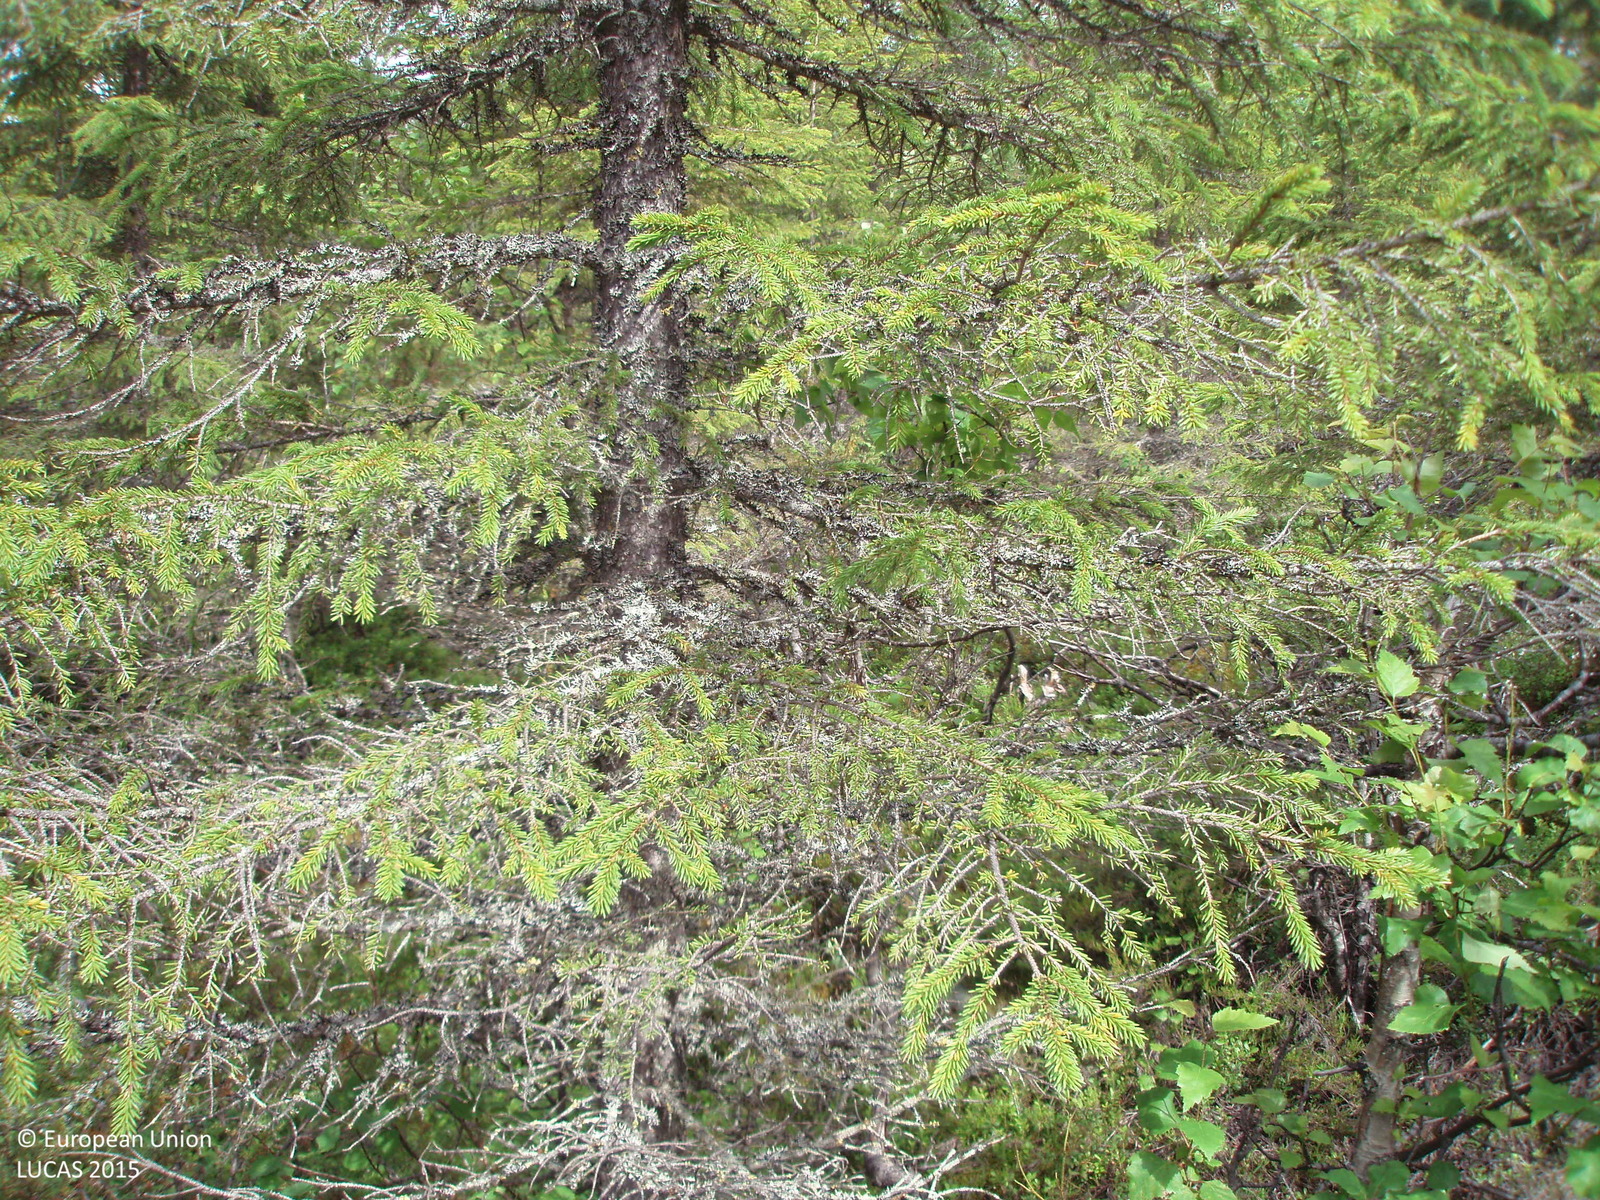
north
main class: Woodland
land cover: Spruce dominated coniferous woodland
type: boreal forest
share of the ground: > 75 %
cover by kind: coniferous forest trees 85 %, shrubs 15 %
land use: Forestry
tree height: > 5 m
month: July
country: FI
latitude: 65.6868
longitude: 27.8332
